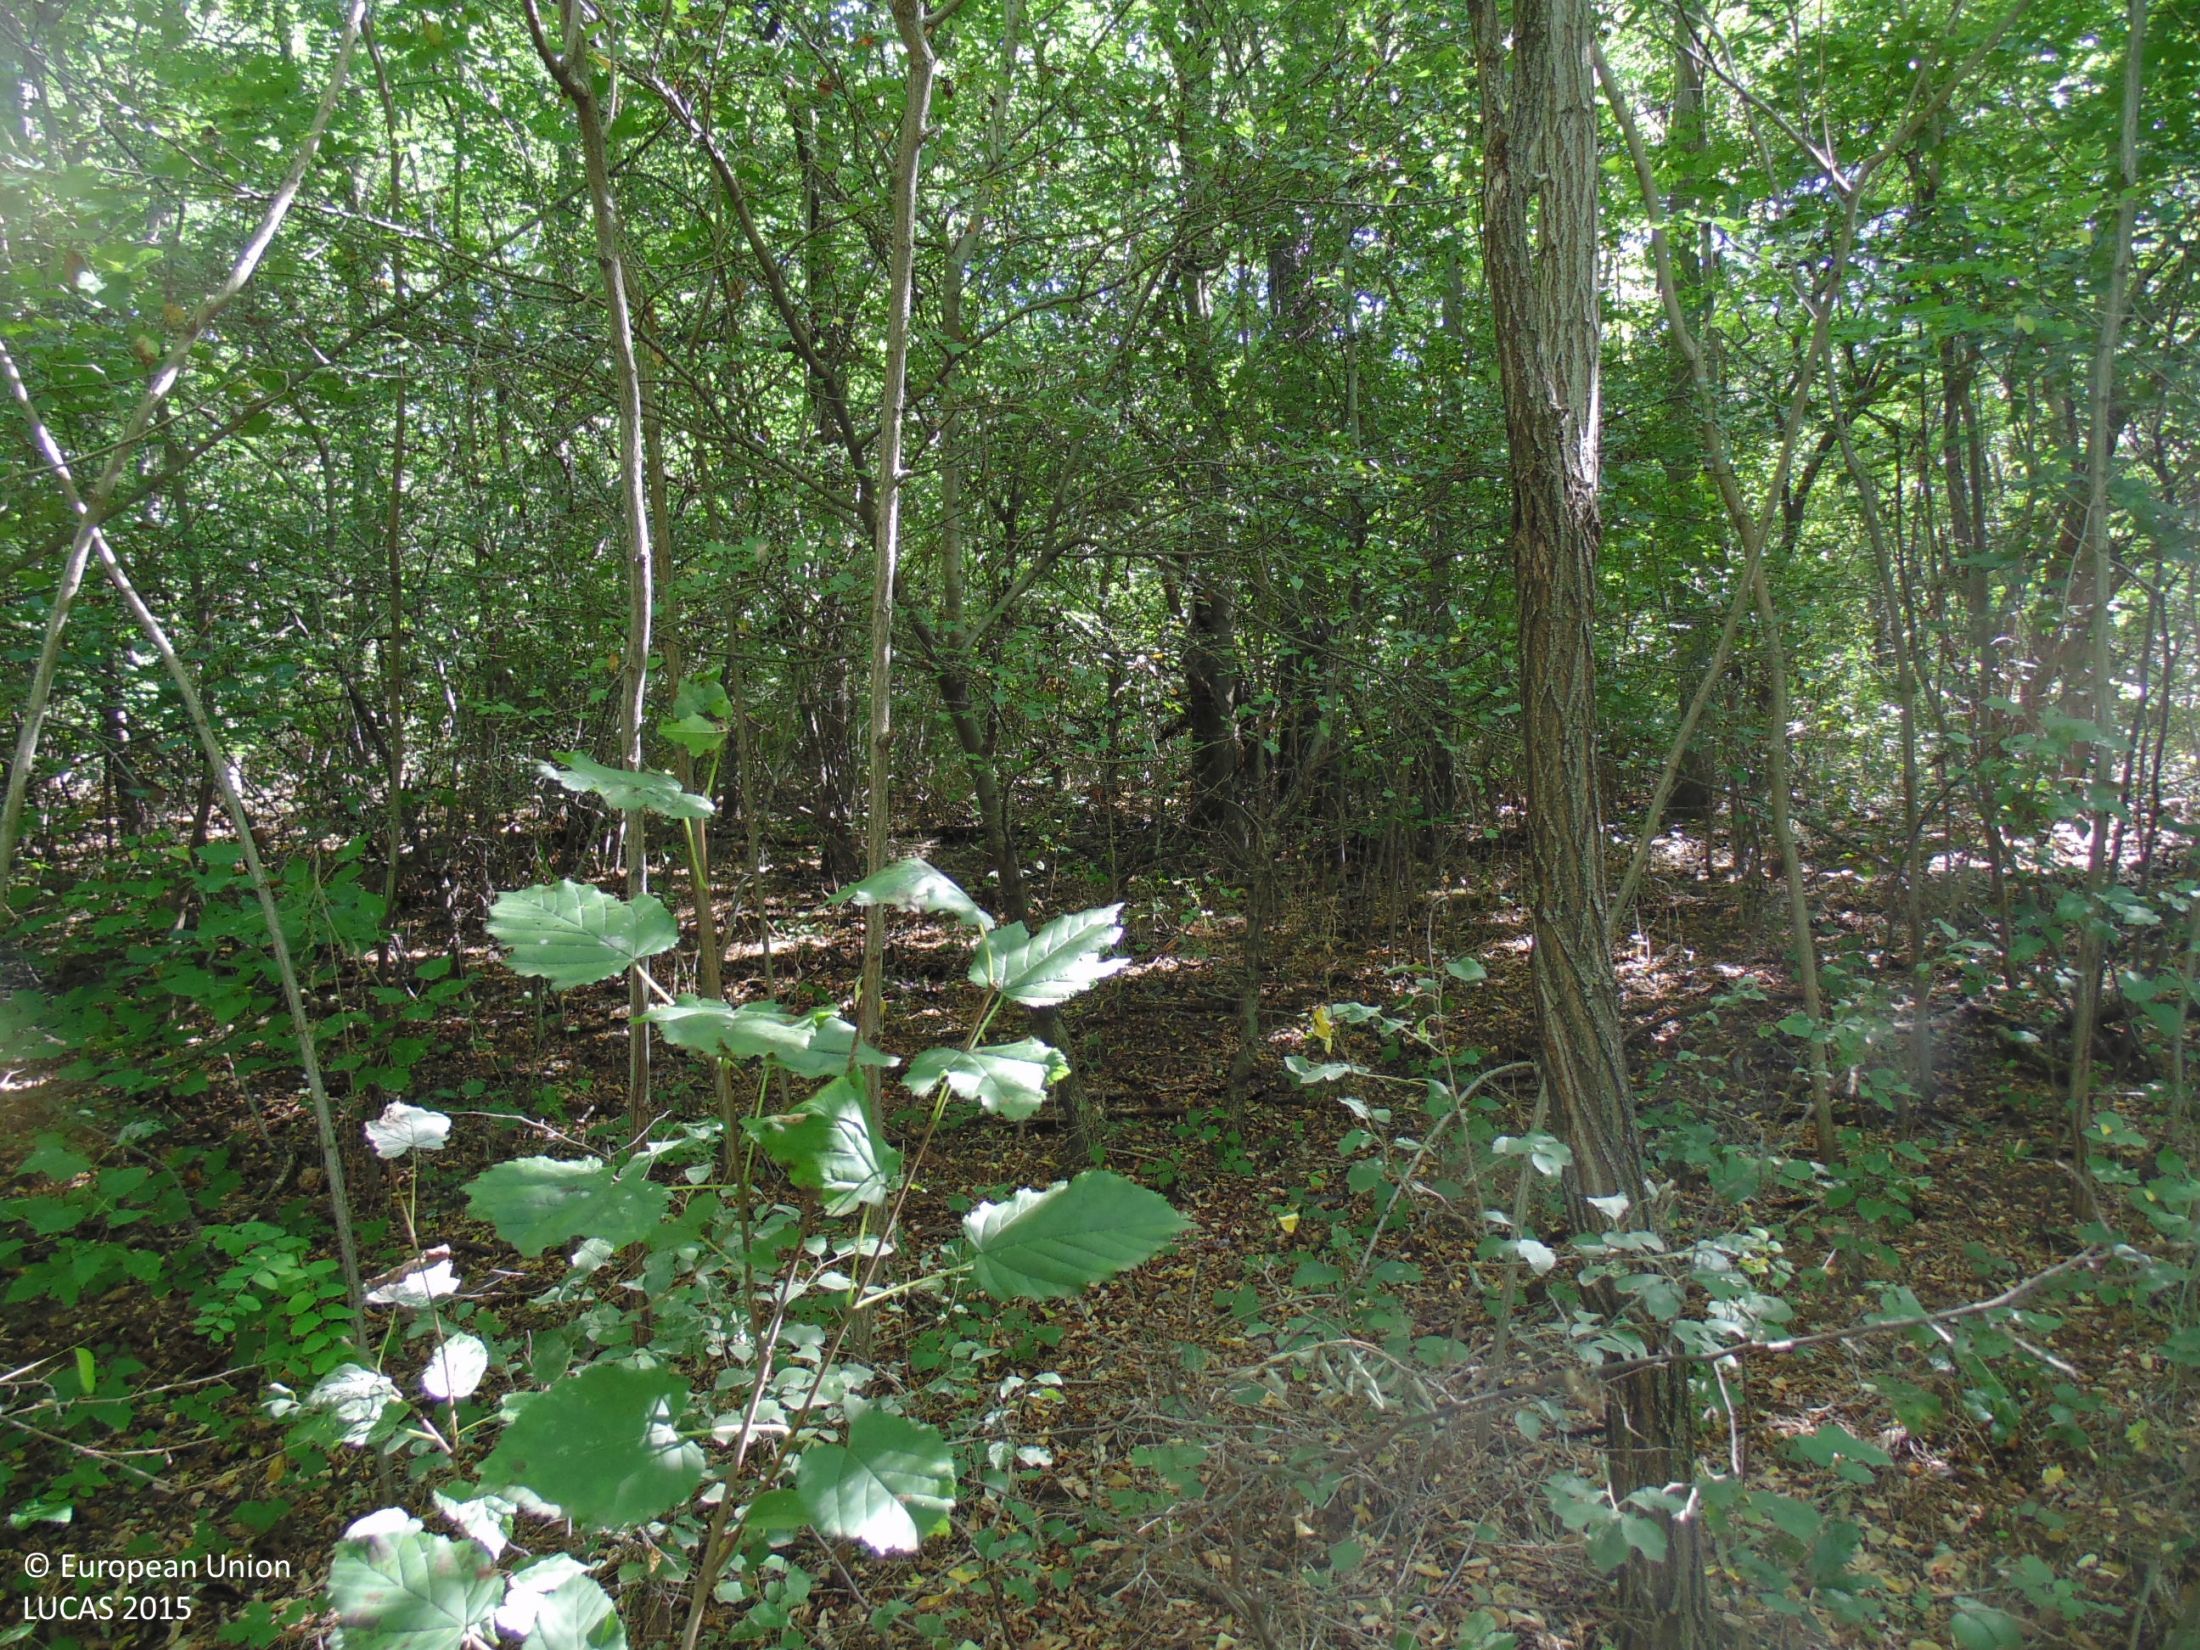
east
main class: Woodland
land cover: Broadleaved woodland
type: mesophytic deciduous forest
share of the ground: > 75 %
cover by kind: broadleaved forest trees 90 %, shrubs 5 %, herbaceous plants 5 %
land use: Forestry
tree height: > 5 m
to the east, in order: Broadleaved woodland
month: September
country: BG
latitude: 44.0771
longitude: 26.9940
